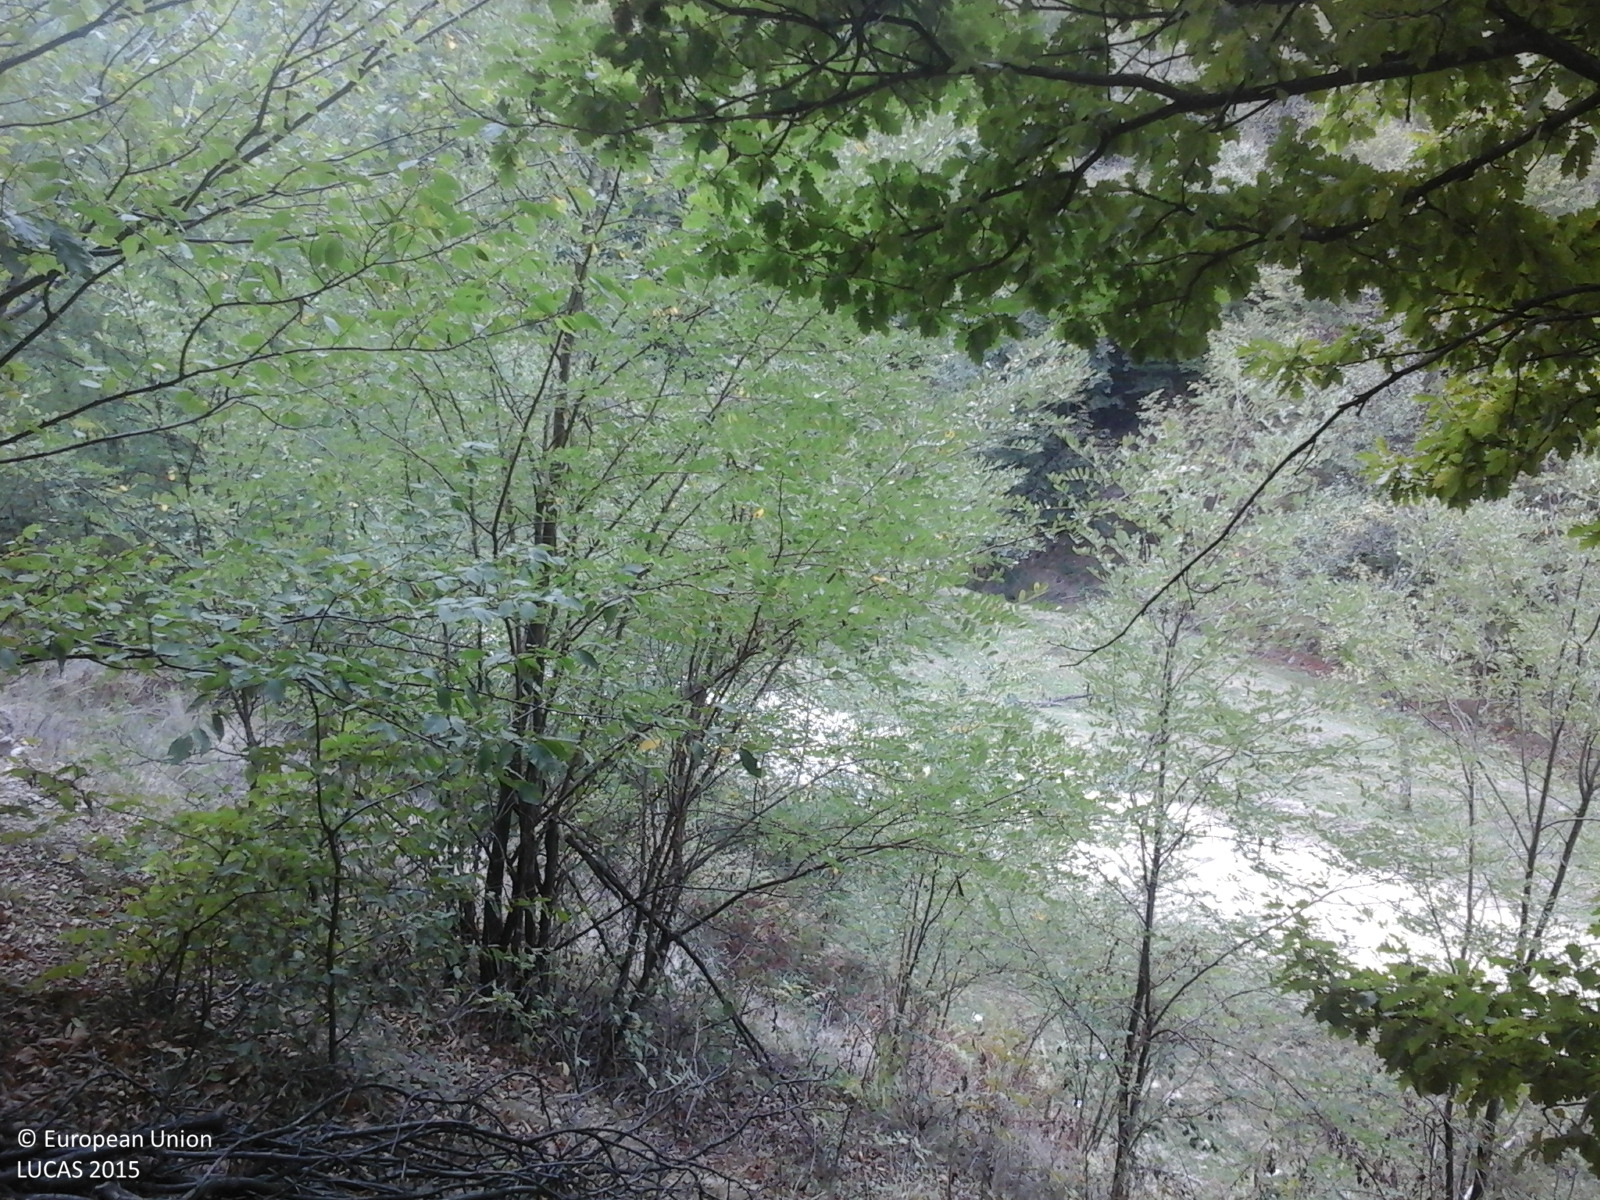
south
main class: Woodland
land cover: Broadleaved woodland
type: acidophilous oak and oak-birch forest
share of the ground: > 75 %
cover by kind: broadleaved forest trees 100 %
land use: Forestry
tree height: > 5 m
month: September
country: RO
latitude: 45.3873
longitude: 22.1090
